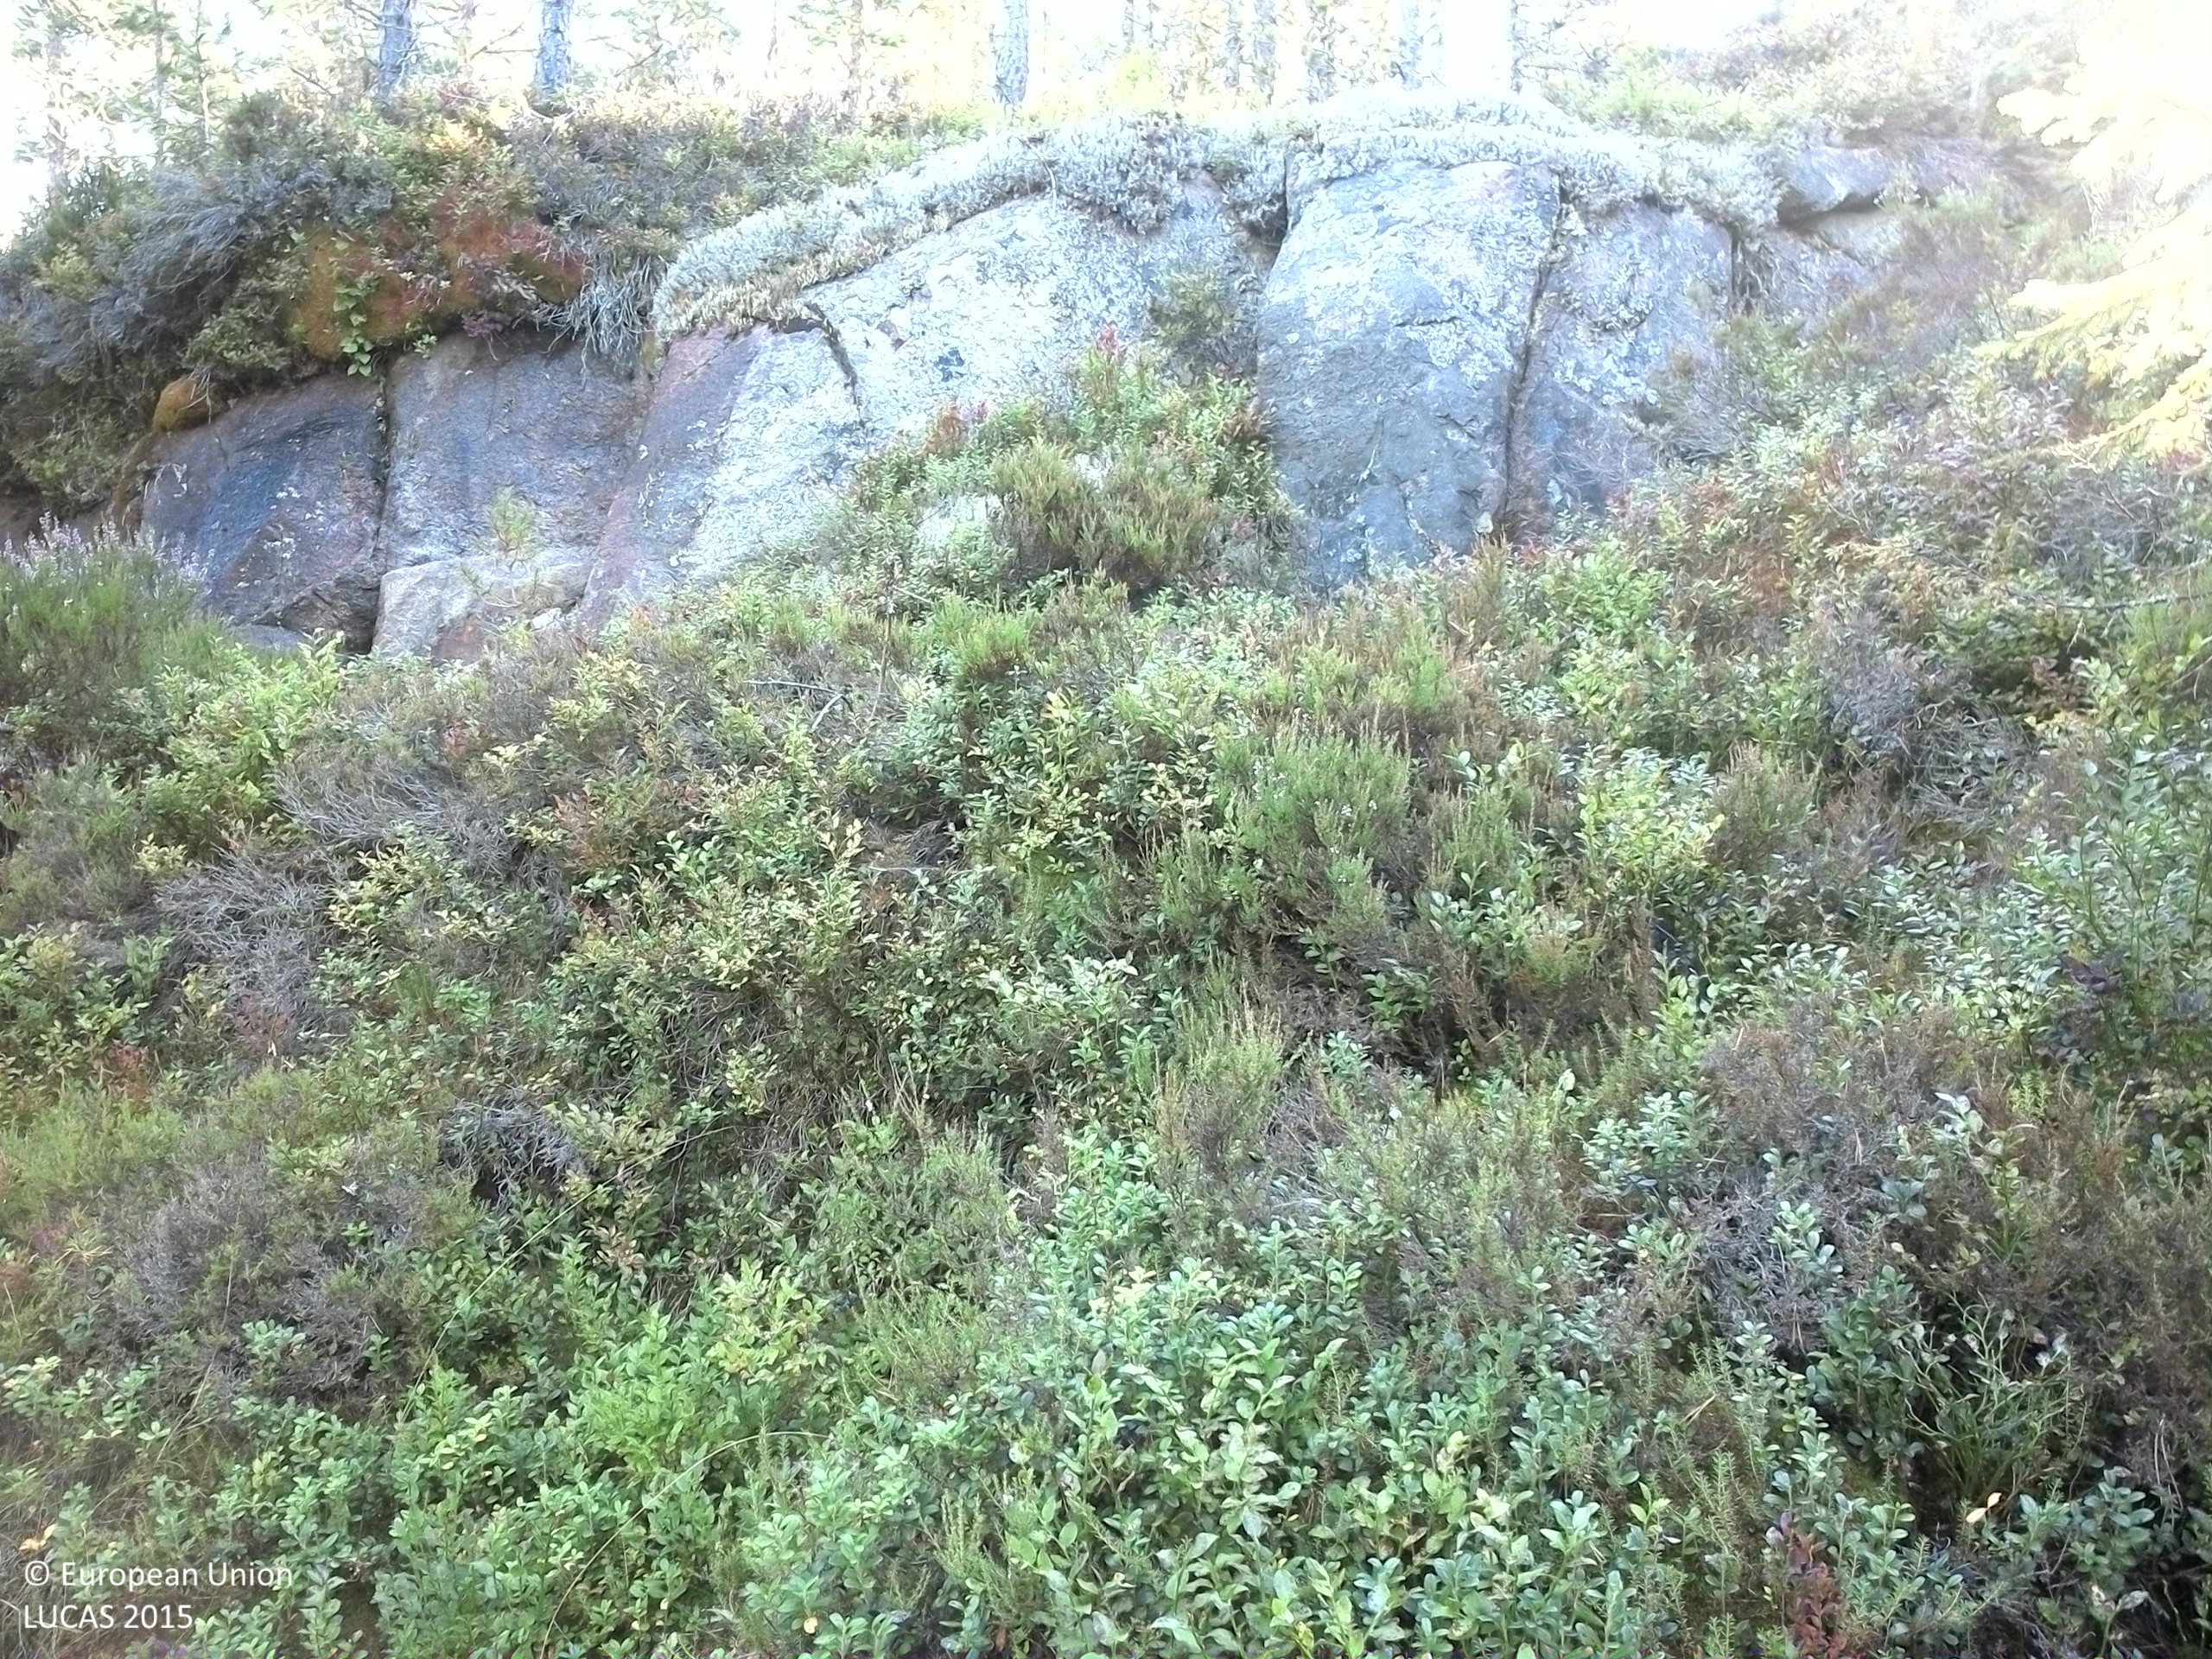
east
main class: Woodland
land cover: Pine dominated coniferous woodland
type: boreal forest
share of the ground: 50 - 75 %
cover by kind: coniferous forest trees 60 %, shrubs 20 %, lichens and mosses 10 %, broadleaved forest trees 5 %, herbaceous plants 5 %
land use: Forestry
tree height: > 5 m
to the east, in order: Pine dominated coniferous woodland; Spontaneously vegetated surfaces; Tracks; Spontaneously vegetated surfaces; Spruce dominated coniferous woodland; Spontaneously vegetated surfaces; Spruce dominated coniferous woodland
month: September
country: SE
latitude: 59.8505
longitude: 13.4362
